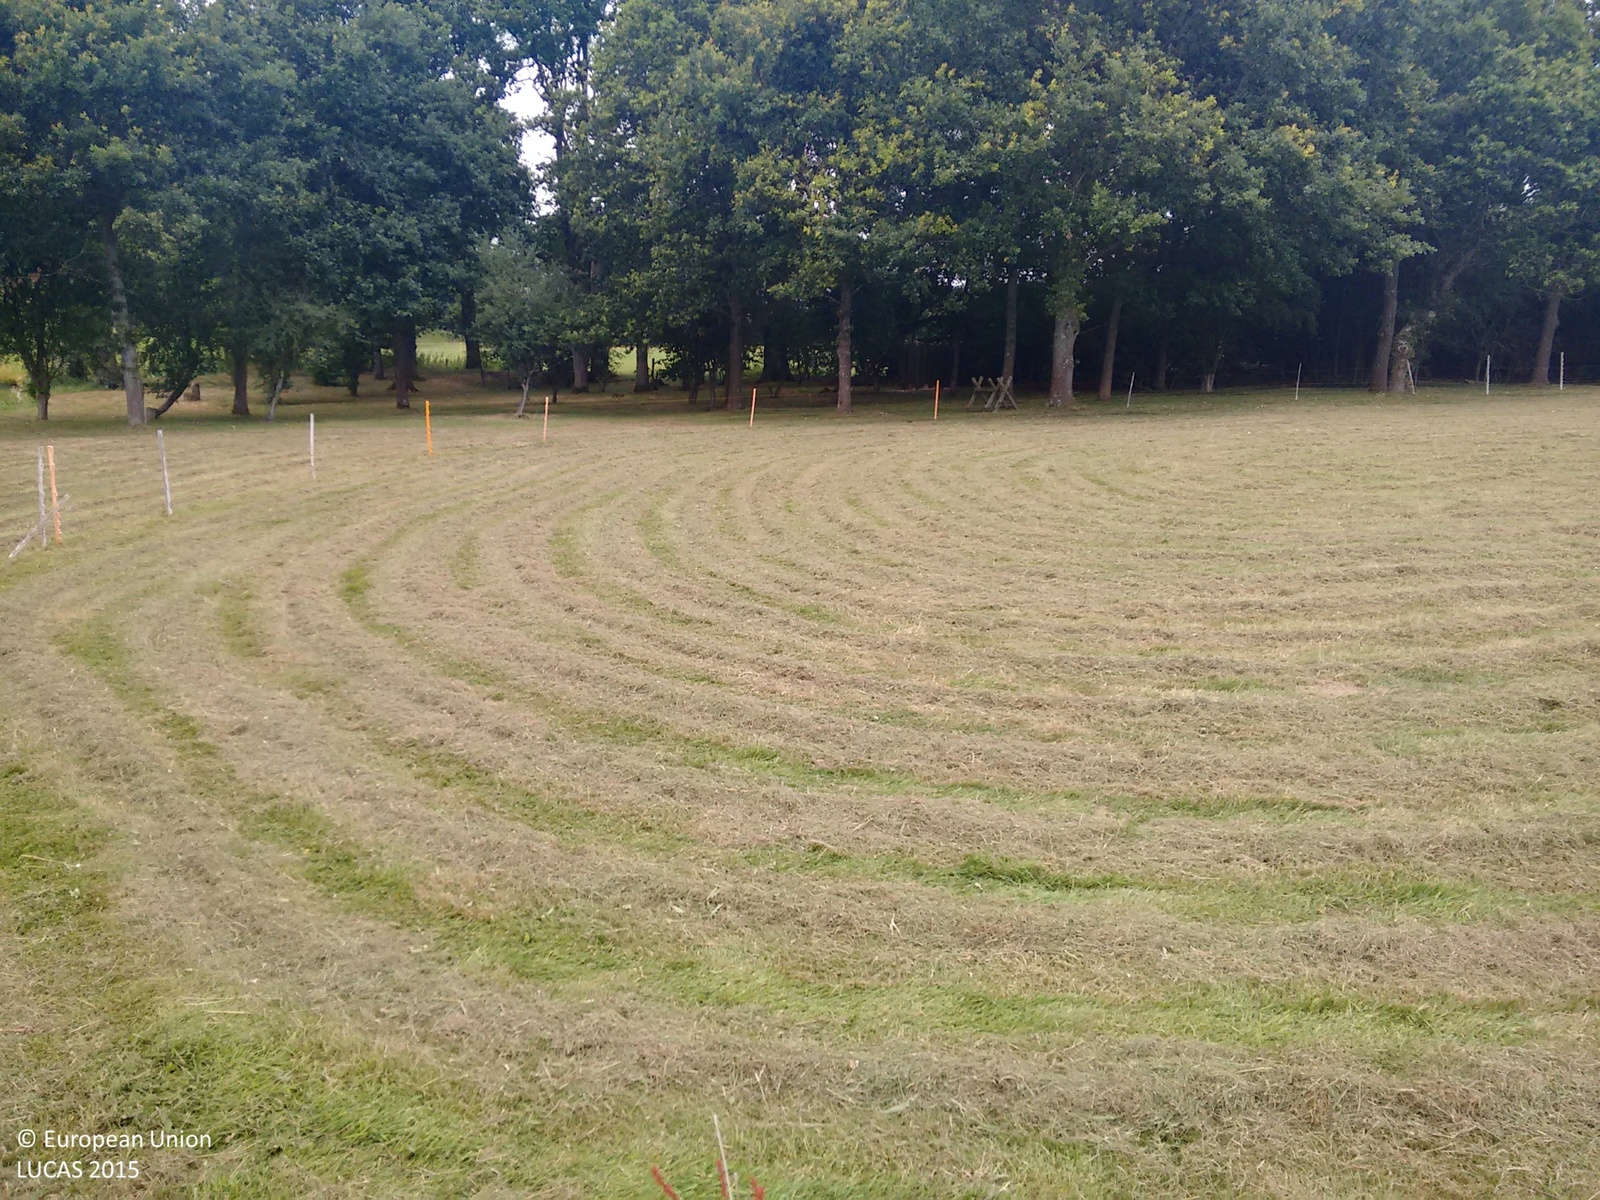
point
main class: Grassland
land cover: Grassland without tree/shrub cover
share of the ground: > 75 %
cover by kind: herbaceous plants 100 %
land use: Residential
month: July
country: GB
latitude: 51.0459
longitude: -0.4359
